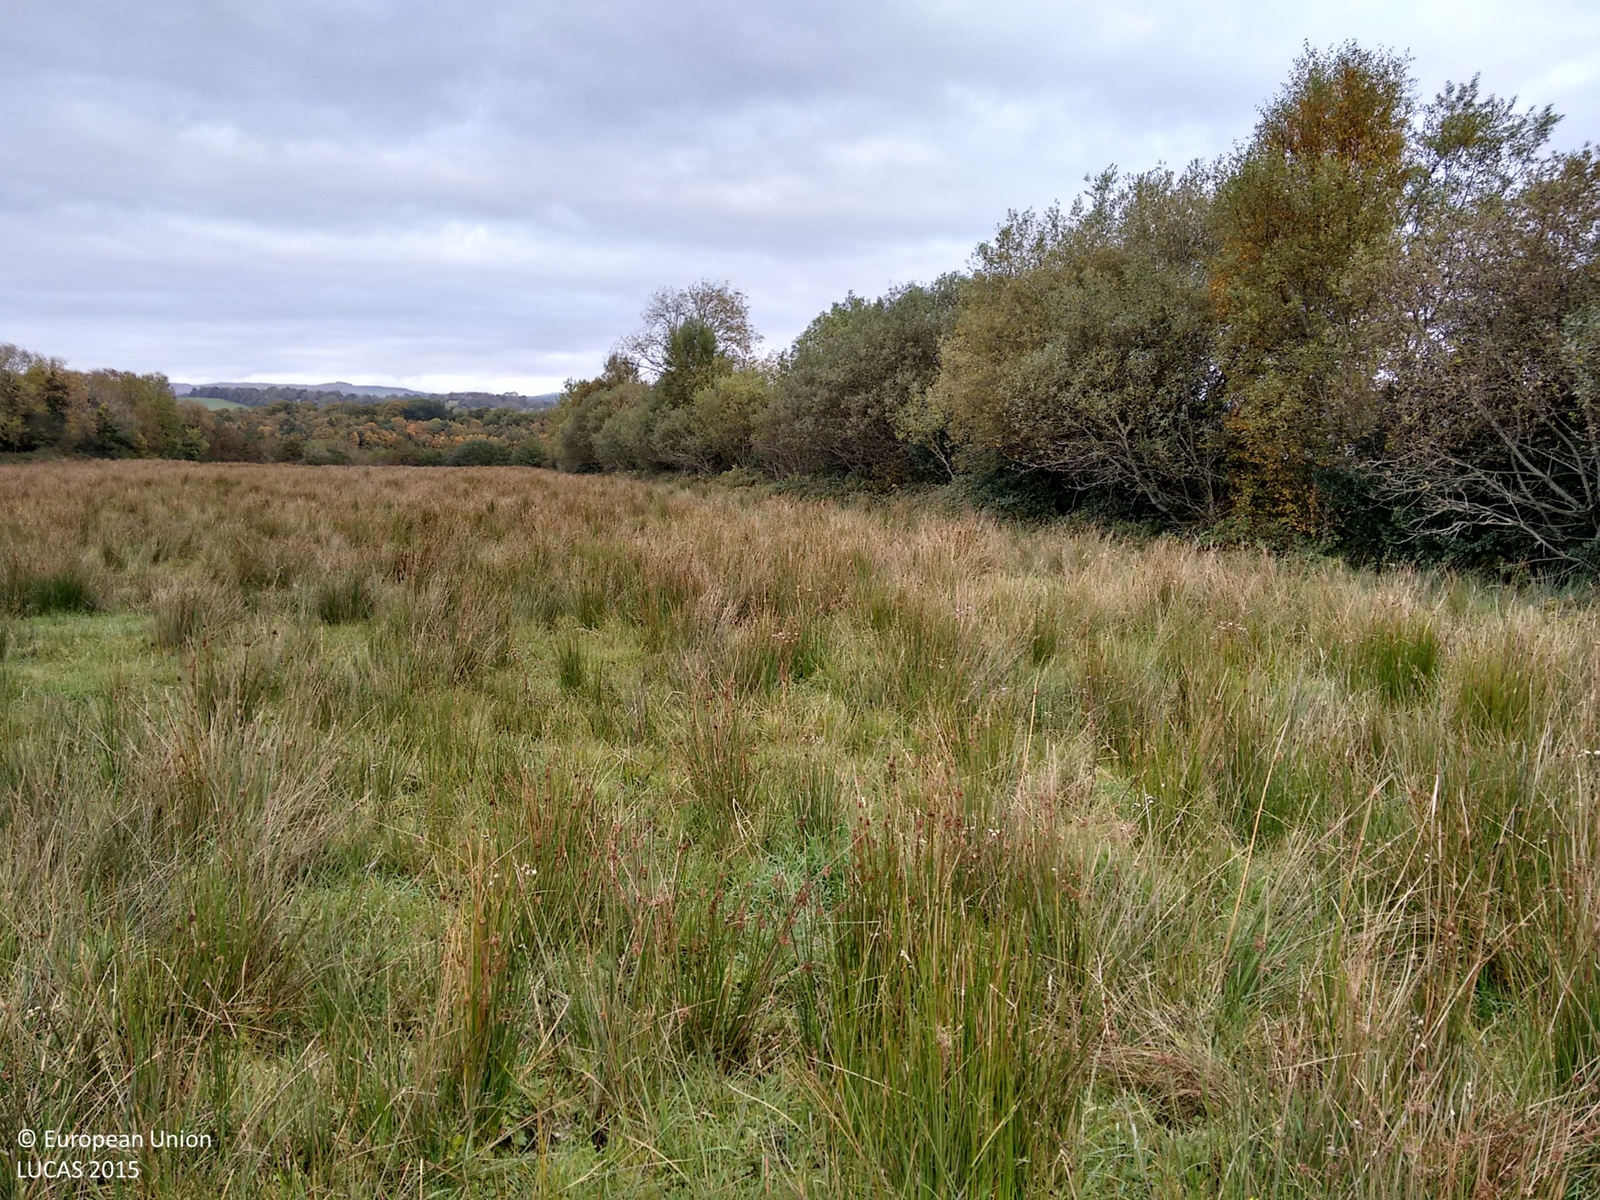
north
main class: Grassland
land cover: Grassland without tree/shrub cover
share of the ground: > 75 %
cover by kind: herbaceous plants 100 %
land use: Agriculture (excluding fallow land and kitchen gardens)
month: October
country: GB
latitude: 54.5132
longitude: -7.8539
